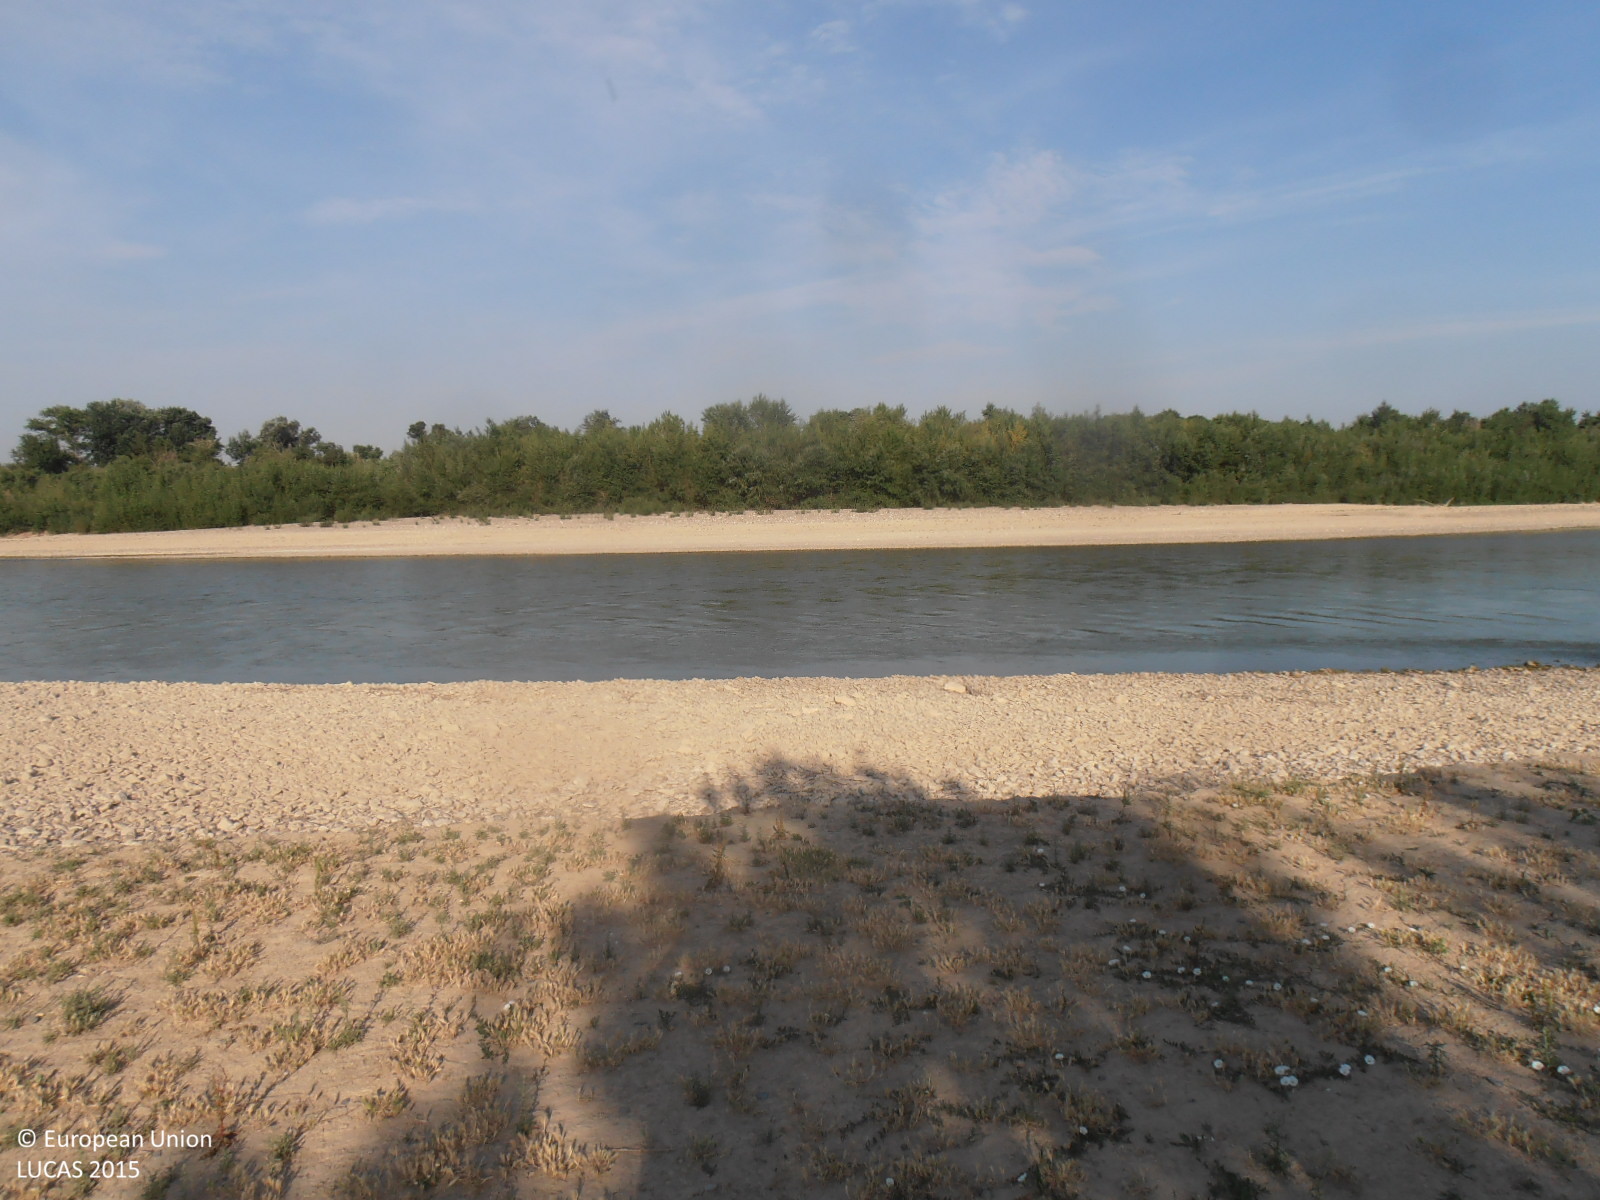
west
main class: Shrubland
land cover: Shrubland without tree cover
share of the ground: 10 - 25 %
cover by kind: herbaceous plants 60 %, shrubs 20 %, unconsolidated bare surface 20 %
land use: Semi-natural and natural areas not in use
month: June
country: ES
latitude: 41.7280
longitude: -0.9750
